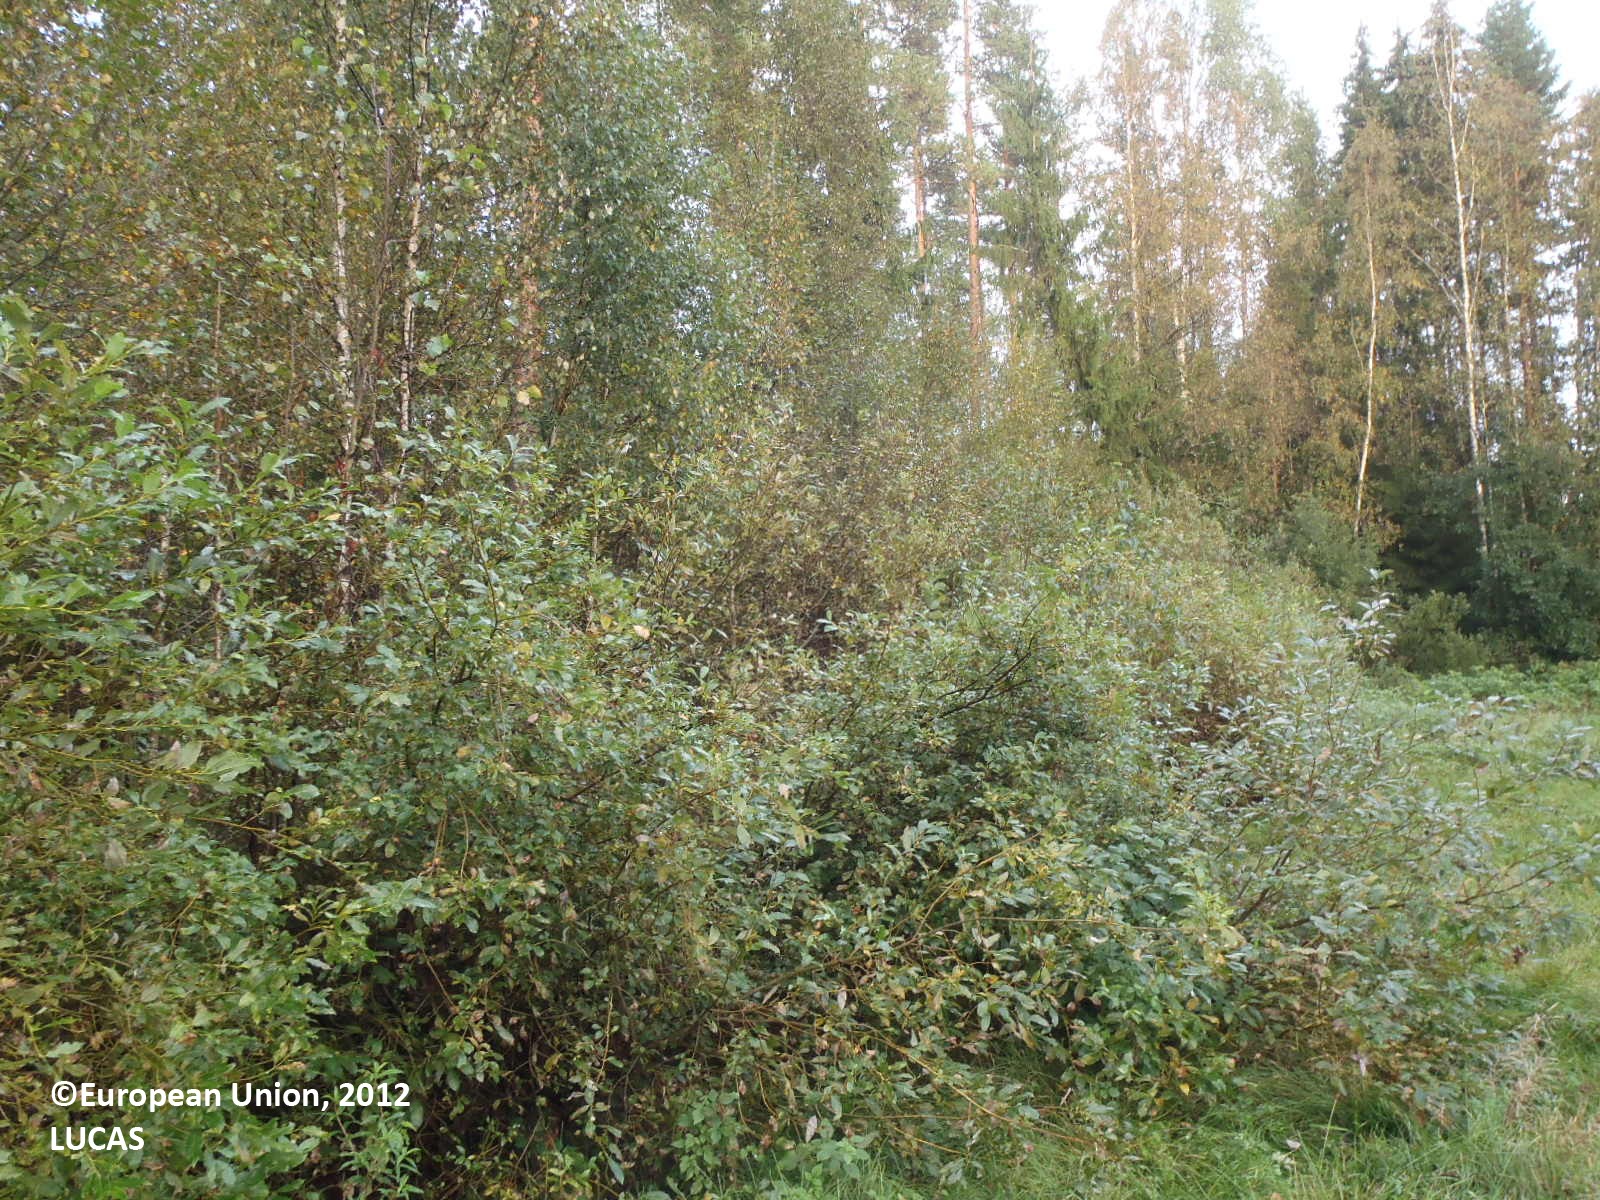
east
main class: Grassland
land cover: Grassland without tree/shrub cover
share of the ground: > 75 %
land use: Agriculture (excluding fallow land and kitchen gardens)
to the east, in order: Grassland without tree/shrub cover; Ditches and canals; Abandoned hedges; Pine dominated mixed woodland; Ditches and canals; Grass margins; Paved roads, cycling and walking lanes; Grass margins; Ditches and canals; Spruce dominated mixed woodland; Ditches and canals; Broadleaved woodland; Ditches and canals; Broadleaved woodland; Ditches and canals
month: September
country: FI
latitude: 61.7061
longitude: 22.4868
